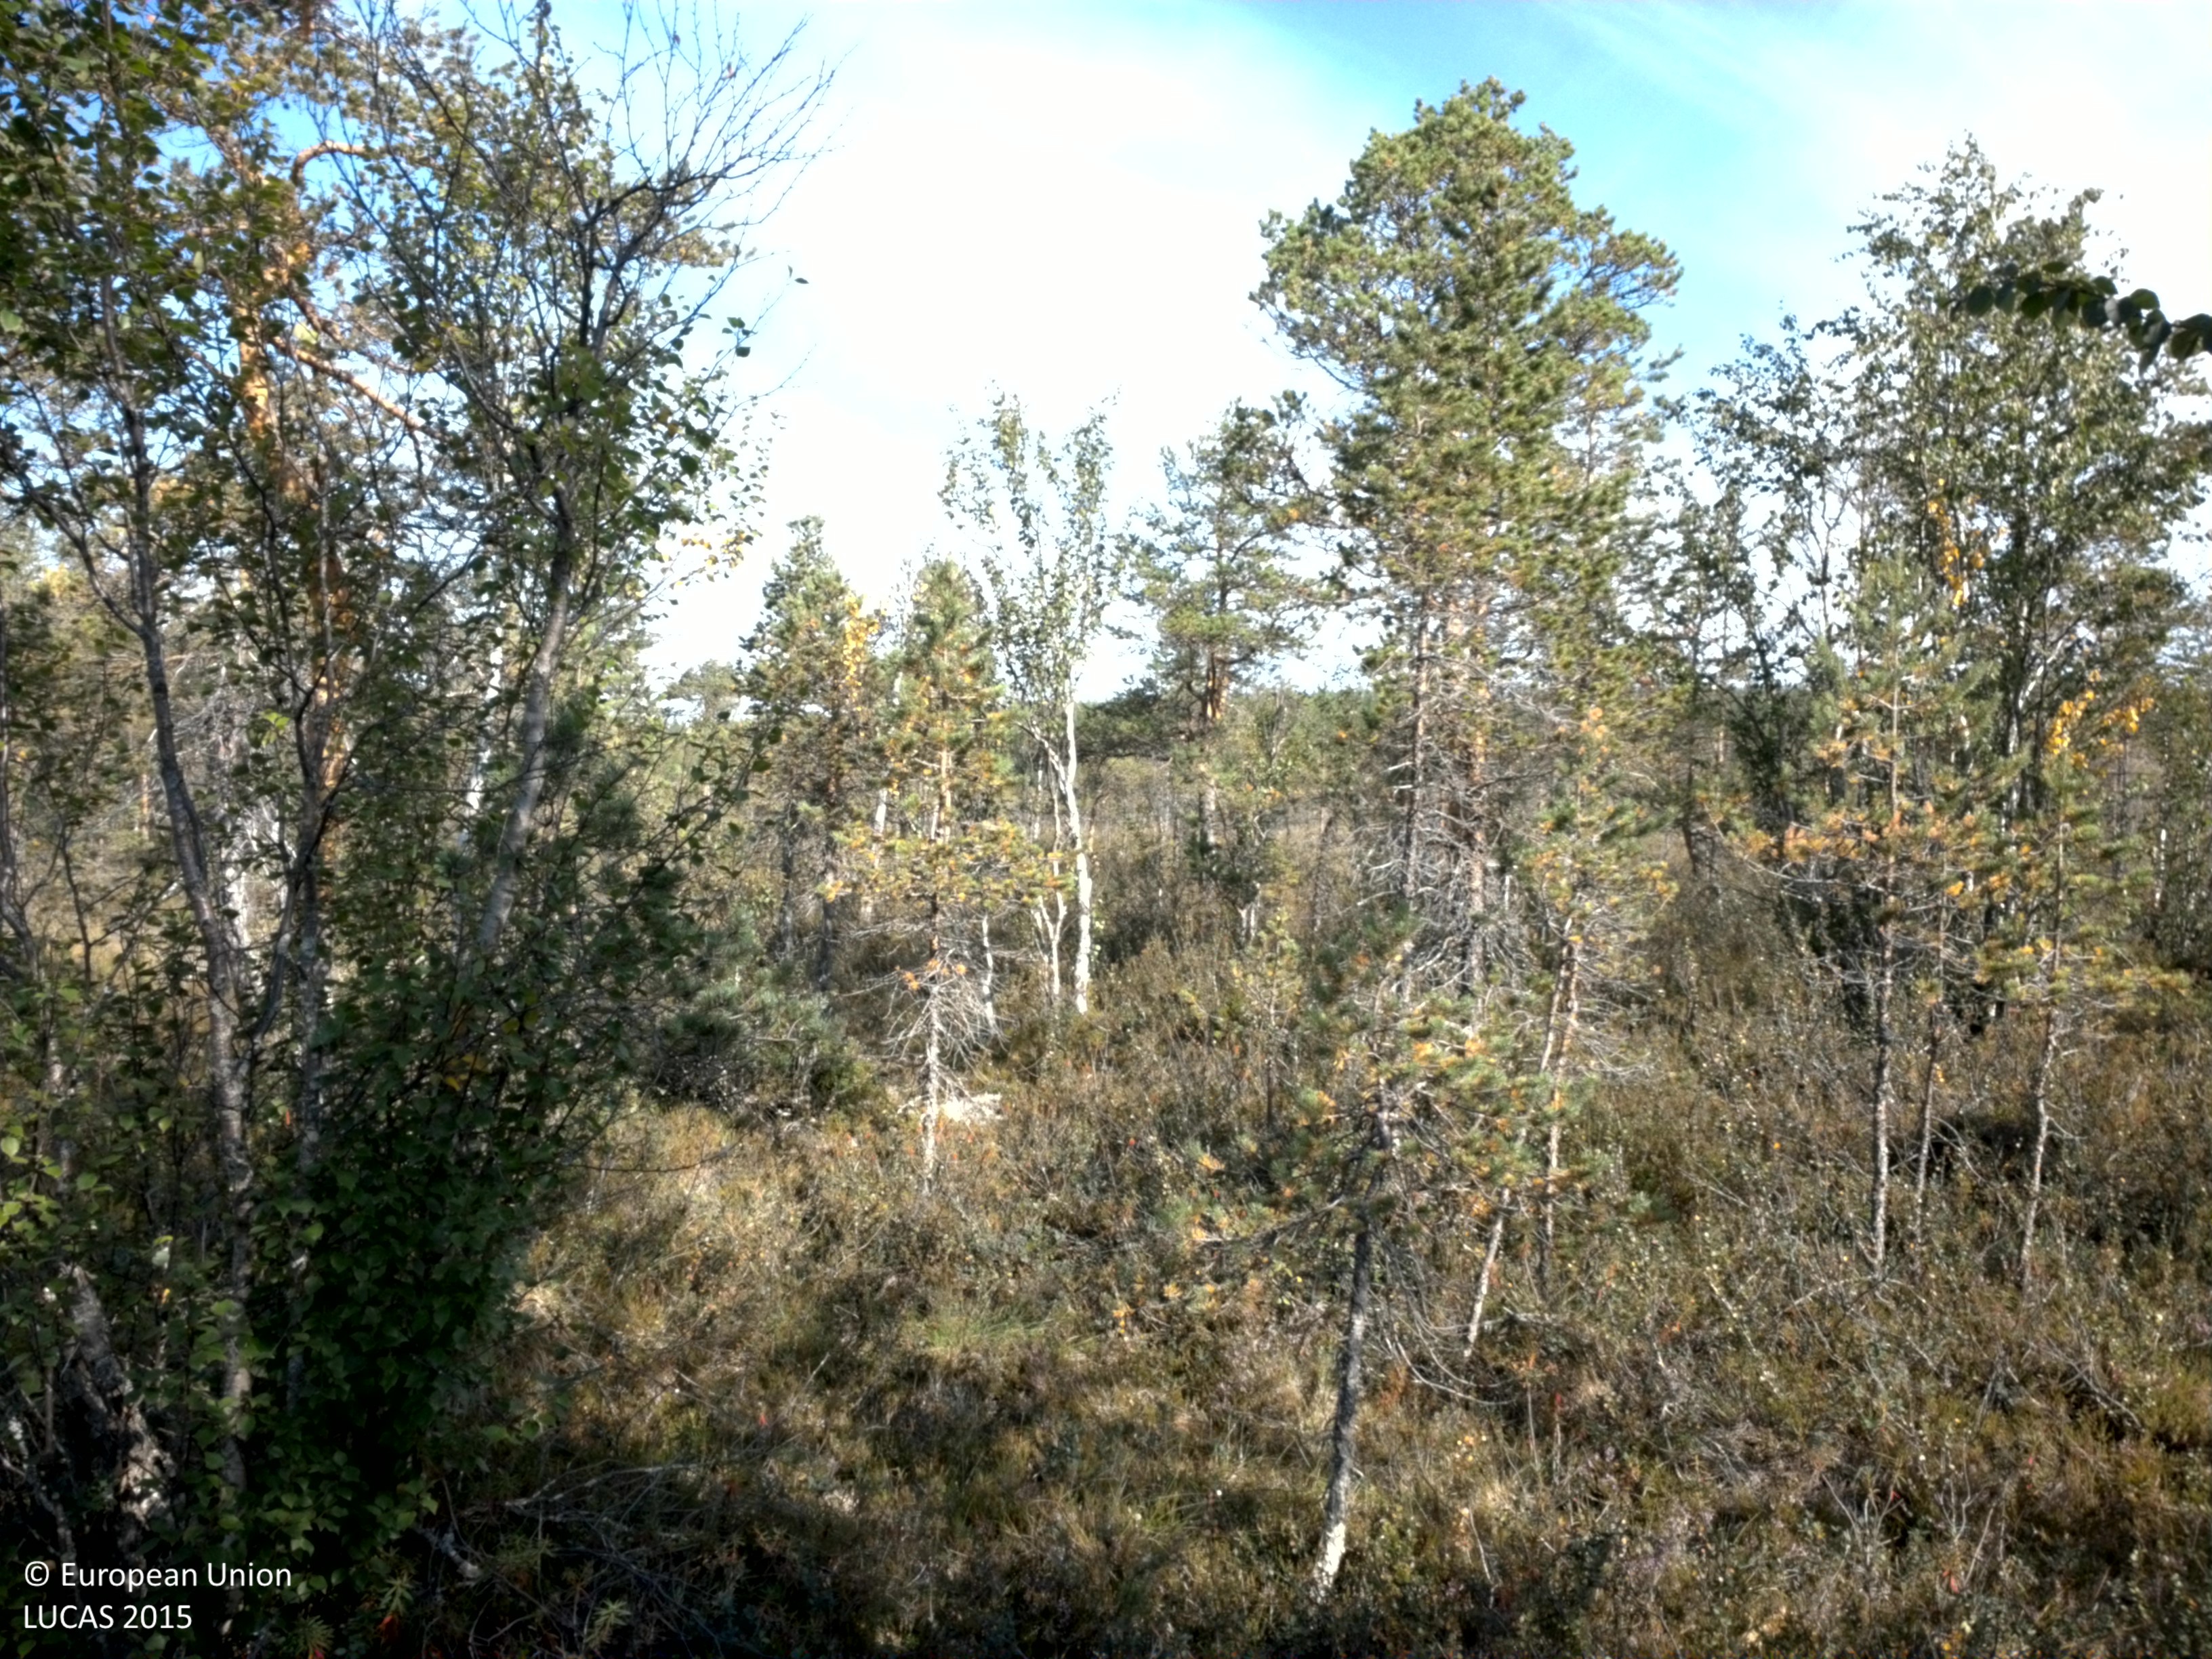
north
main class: Woodland
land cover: Pine dominated mixed woodland
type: boreal forest
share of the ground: 50 - 75 %
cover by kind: coniferous forest trees 45 %, shrubs 35 %, broadleaved forest trees 15 %, lichens and mosses 5 %
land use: Semi-natural and natural areas not in use
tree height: > 5 m
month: August
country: SE
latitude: 64.6124
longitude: 18.7269
